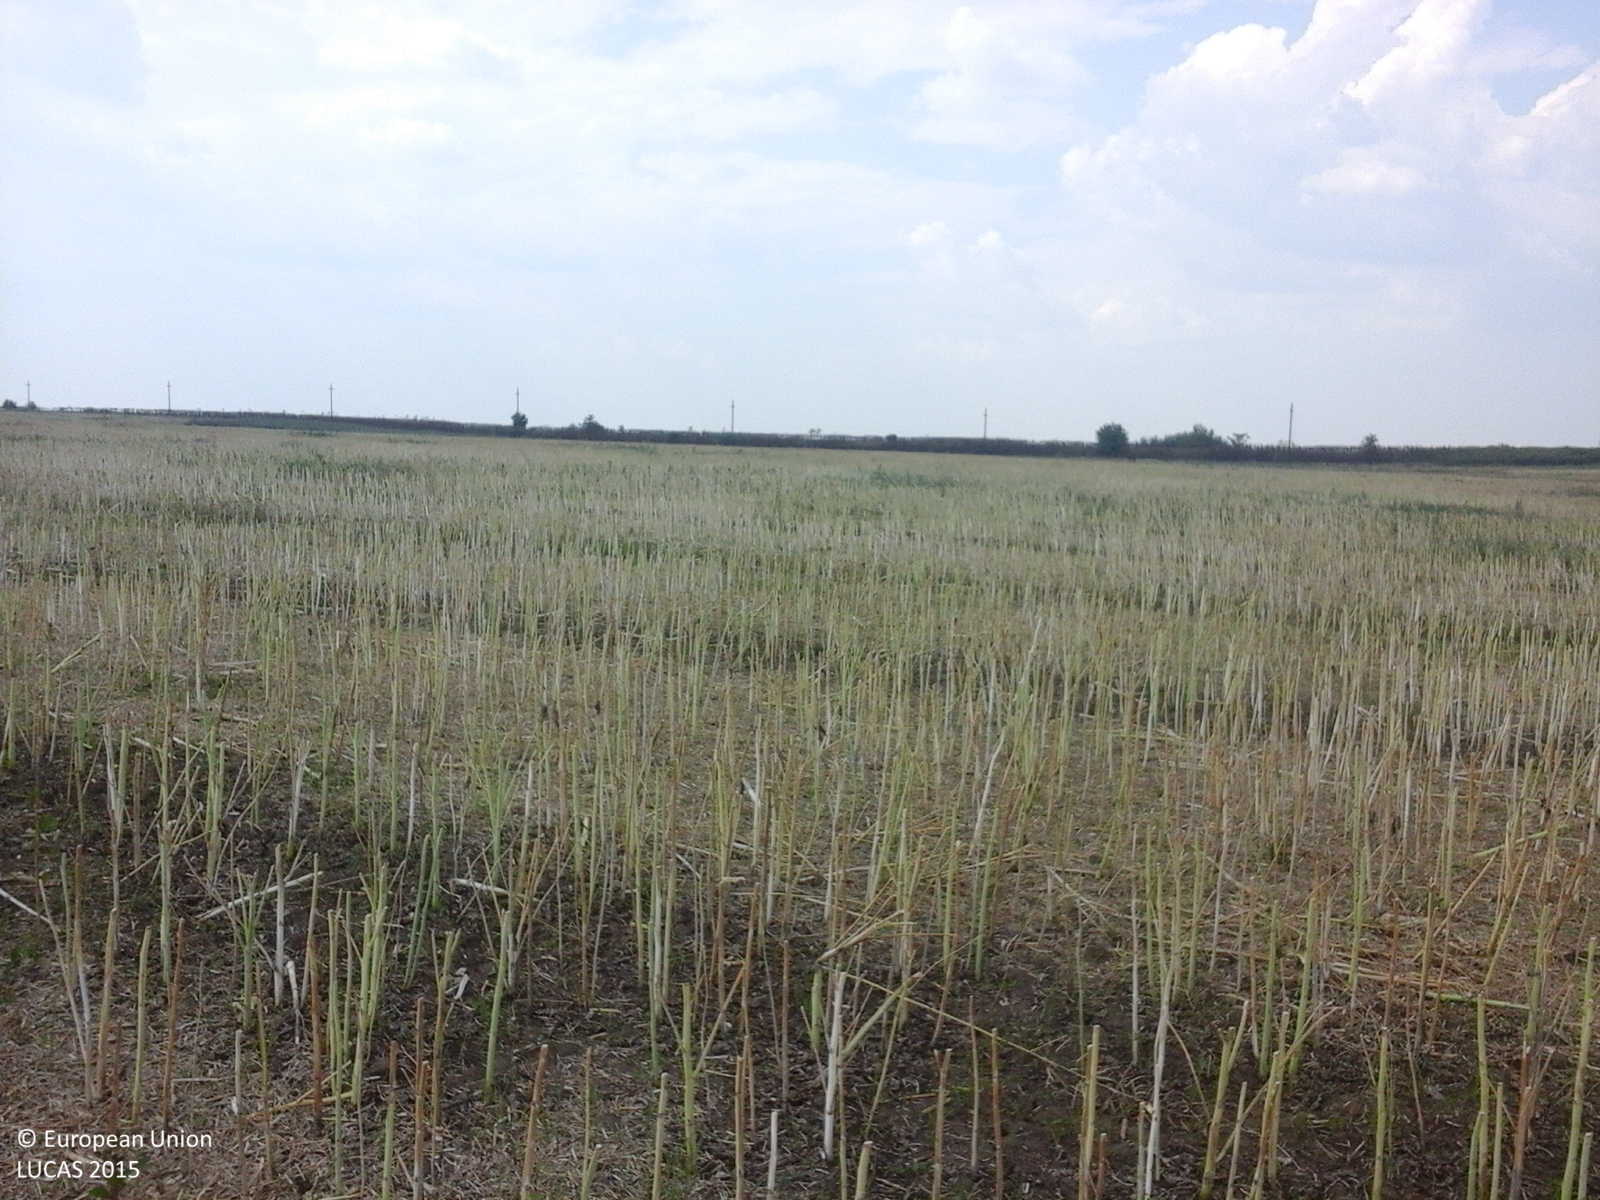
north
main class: Cropland
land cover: Rape and turnip rape
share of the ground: < 10 %
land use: Agriculture (excluding fallow land and kitchen gardens)
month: July
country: RO
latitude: 43.8801
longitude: 24.8452
